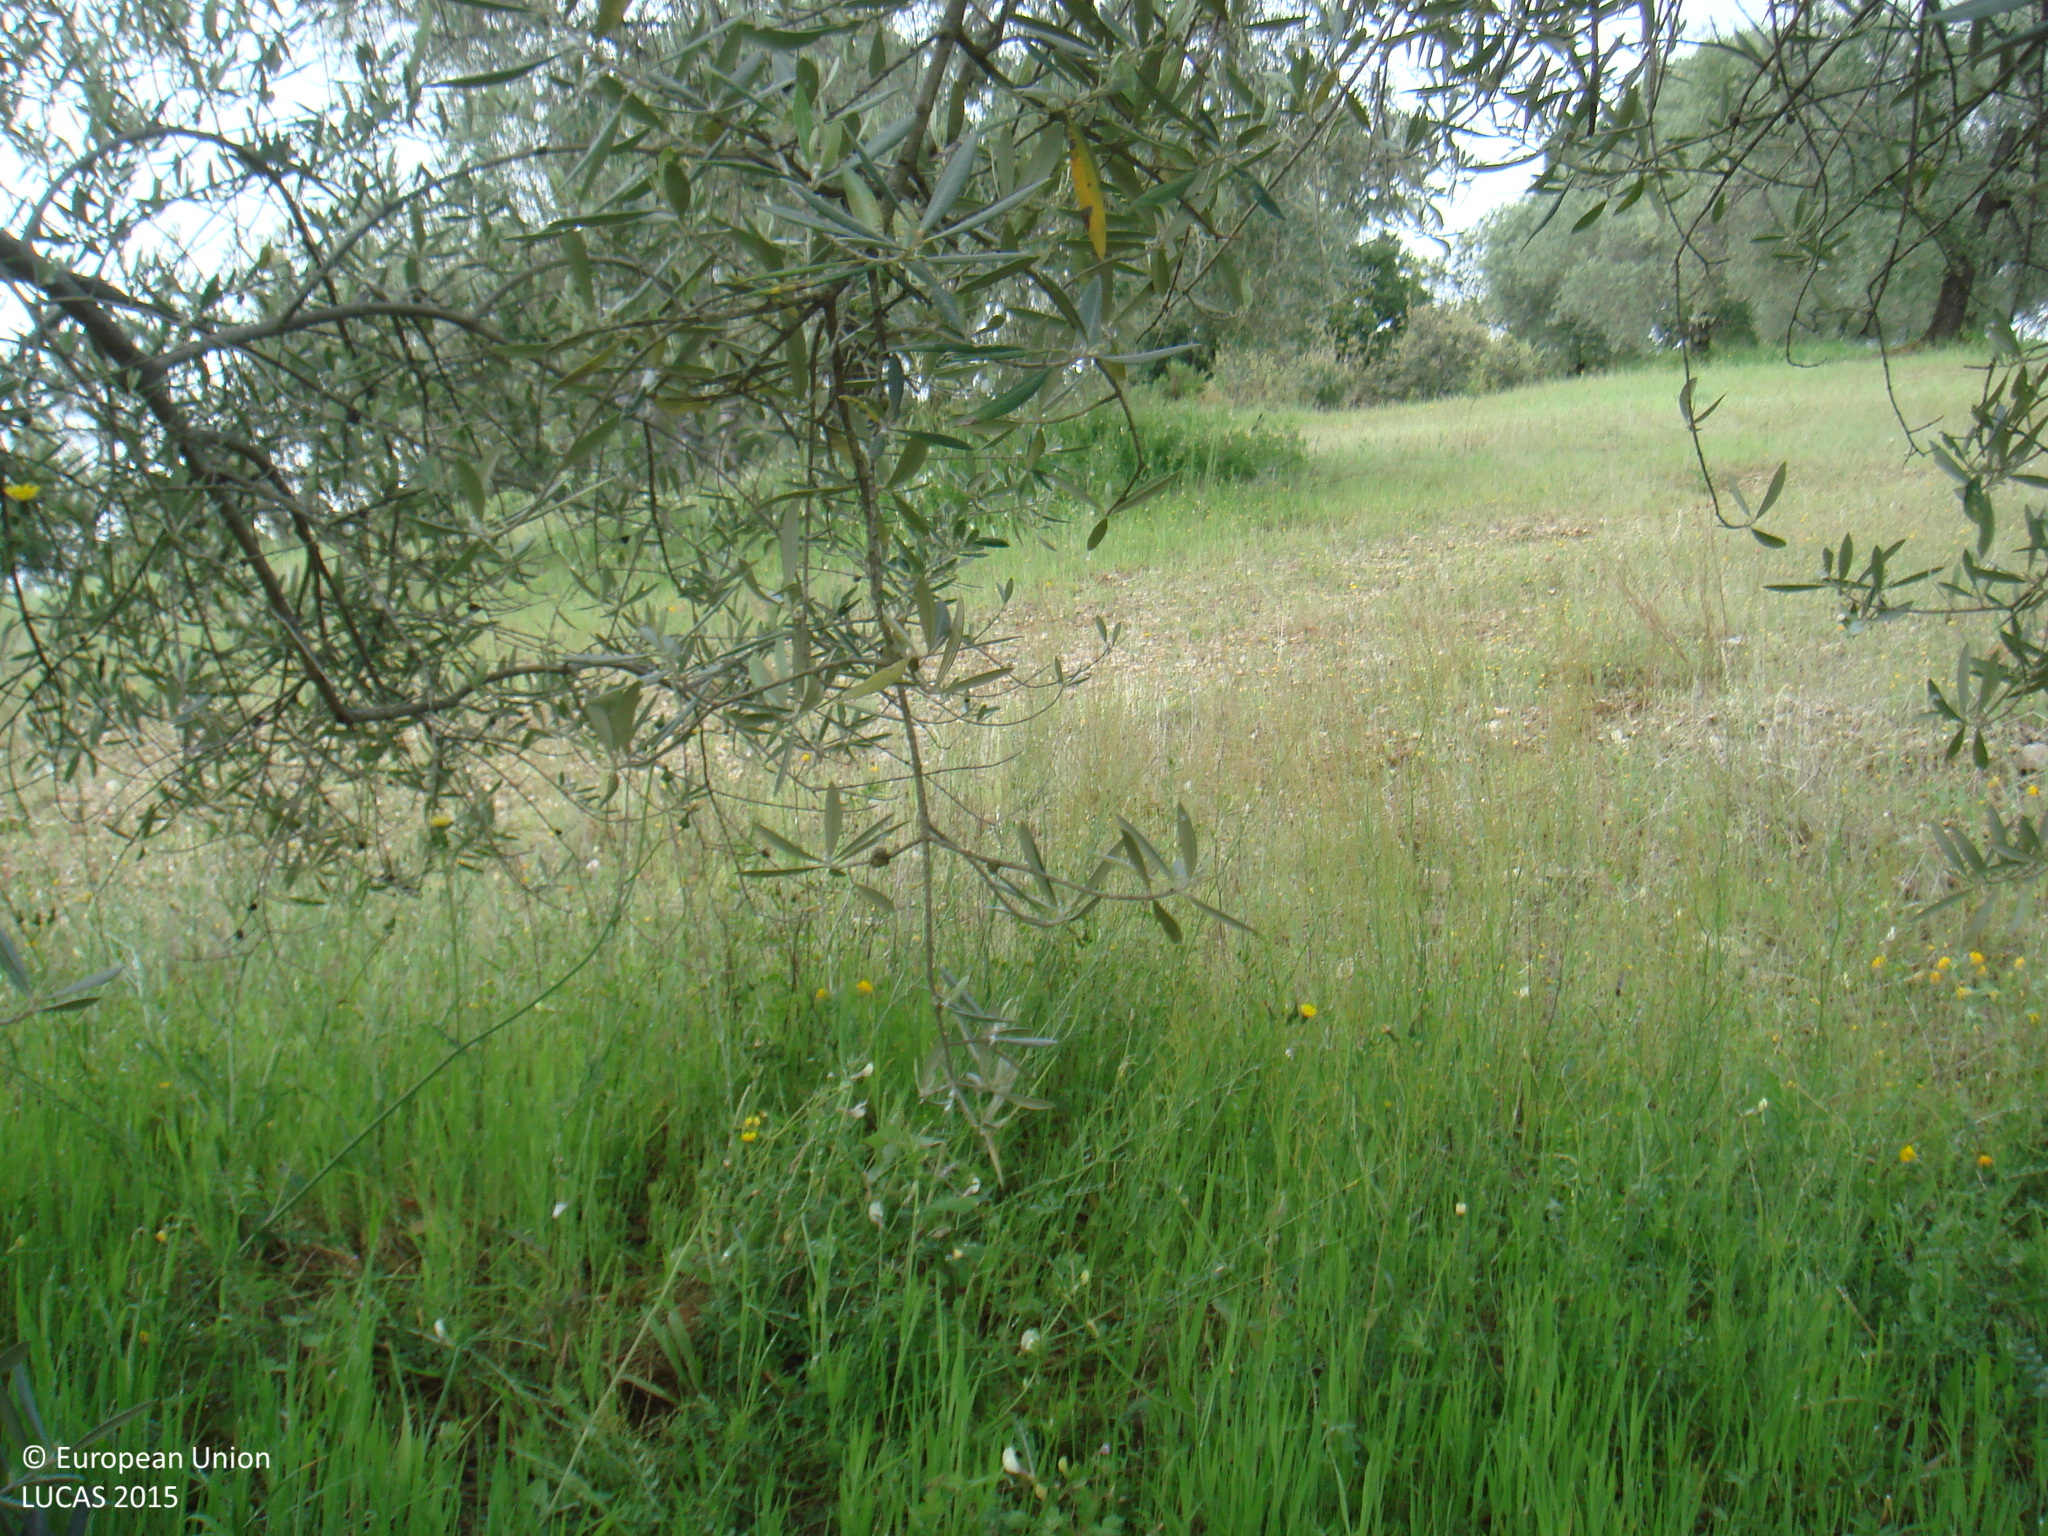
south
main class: Cropland
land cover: Olive groves
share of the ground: 10 - 25 %
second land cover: Spontaneously vegetated surfaces
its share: > 75 %
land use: Agriculture (excluding fallow land and kitchen gardens)
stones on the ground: 10 - 25 %
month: April
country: ES
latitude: 38.0793
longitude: -4.9891
